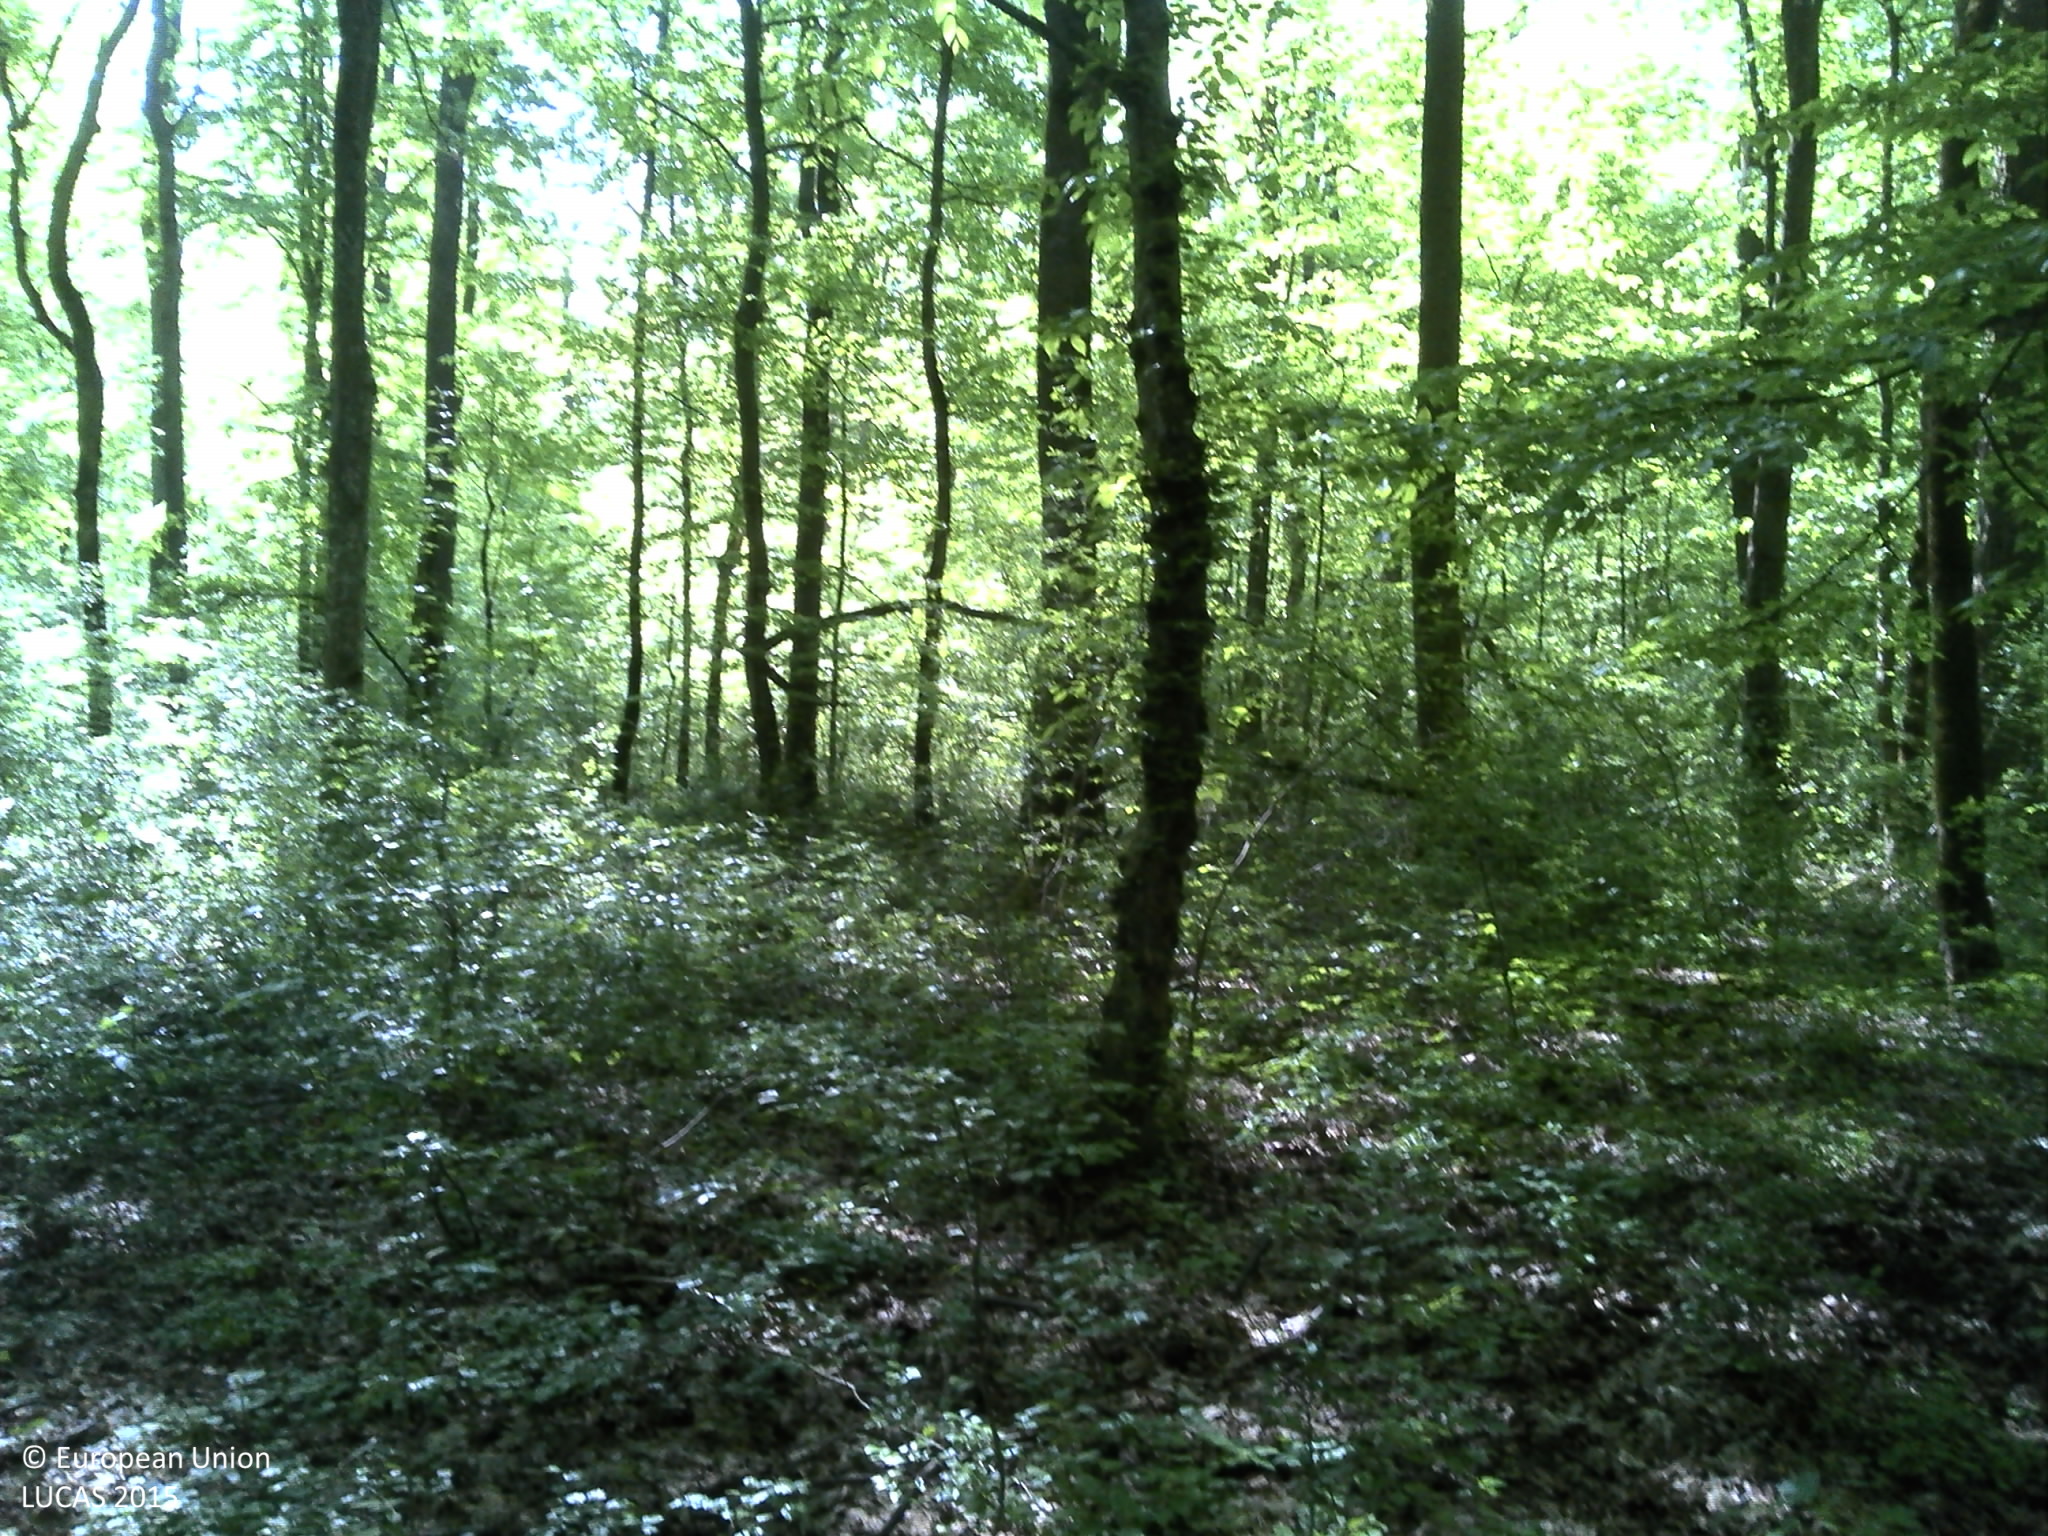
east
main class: Woodland
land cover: Broadleaved woodland
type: mesophytic deciduous forest
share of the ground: > 75 %
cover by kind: broadleaved forest trees 90 %, shrubs 10 %
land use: Forestry
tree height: > 5 m
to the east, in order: Broadleaved woodland
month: April
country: HR
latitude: 44.9724
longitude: 19.0224
